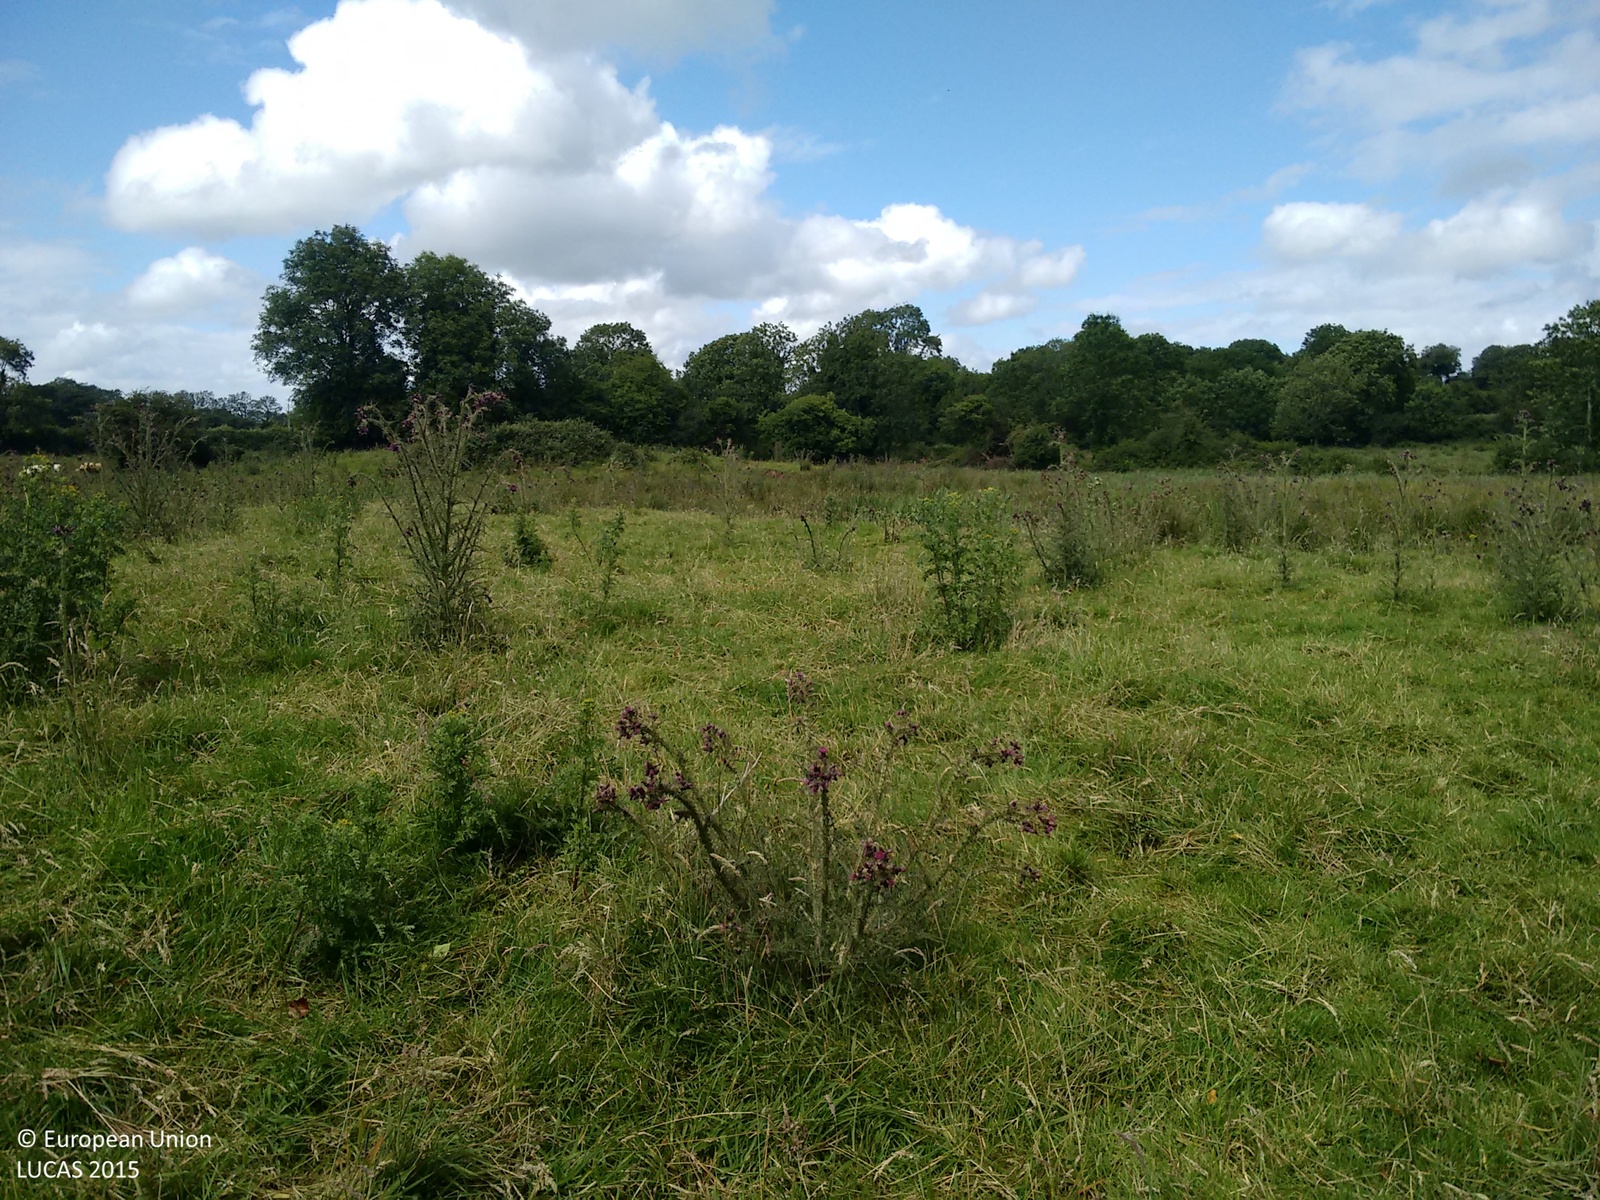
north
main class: Grassland
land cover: Grassland without tree/shrub cover
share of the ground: > 75 %
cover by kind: herbaceous plants 95 %, shrubs 5 %
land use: Agriculture (excluding fallow land and kitchen gardens)
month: July
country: IE
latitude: 53.6110
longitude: -7.7135
